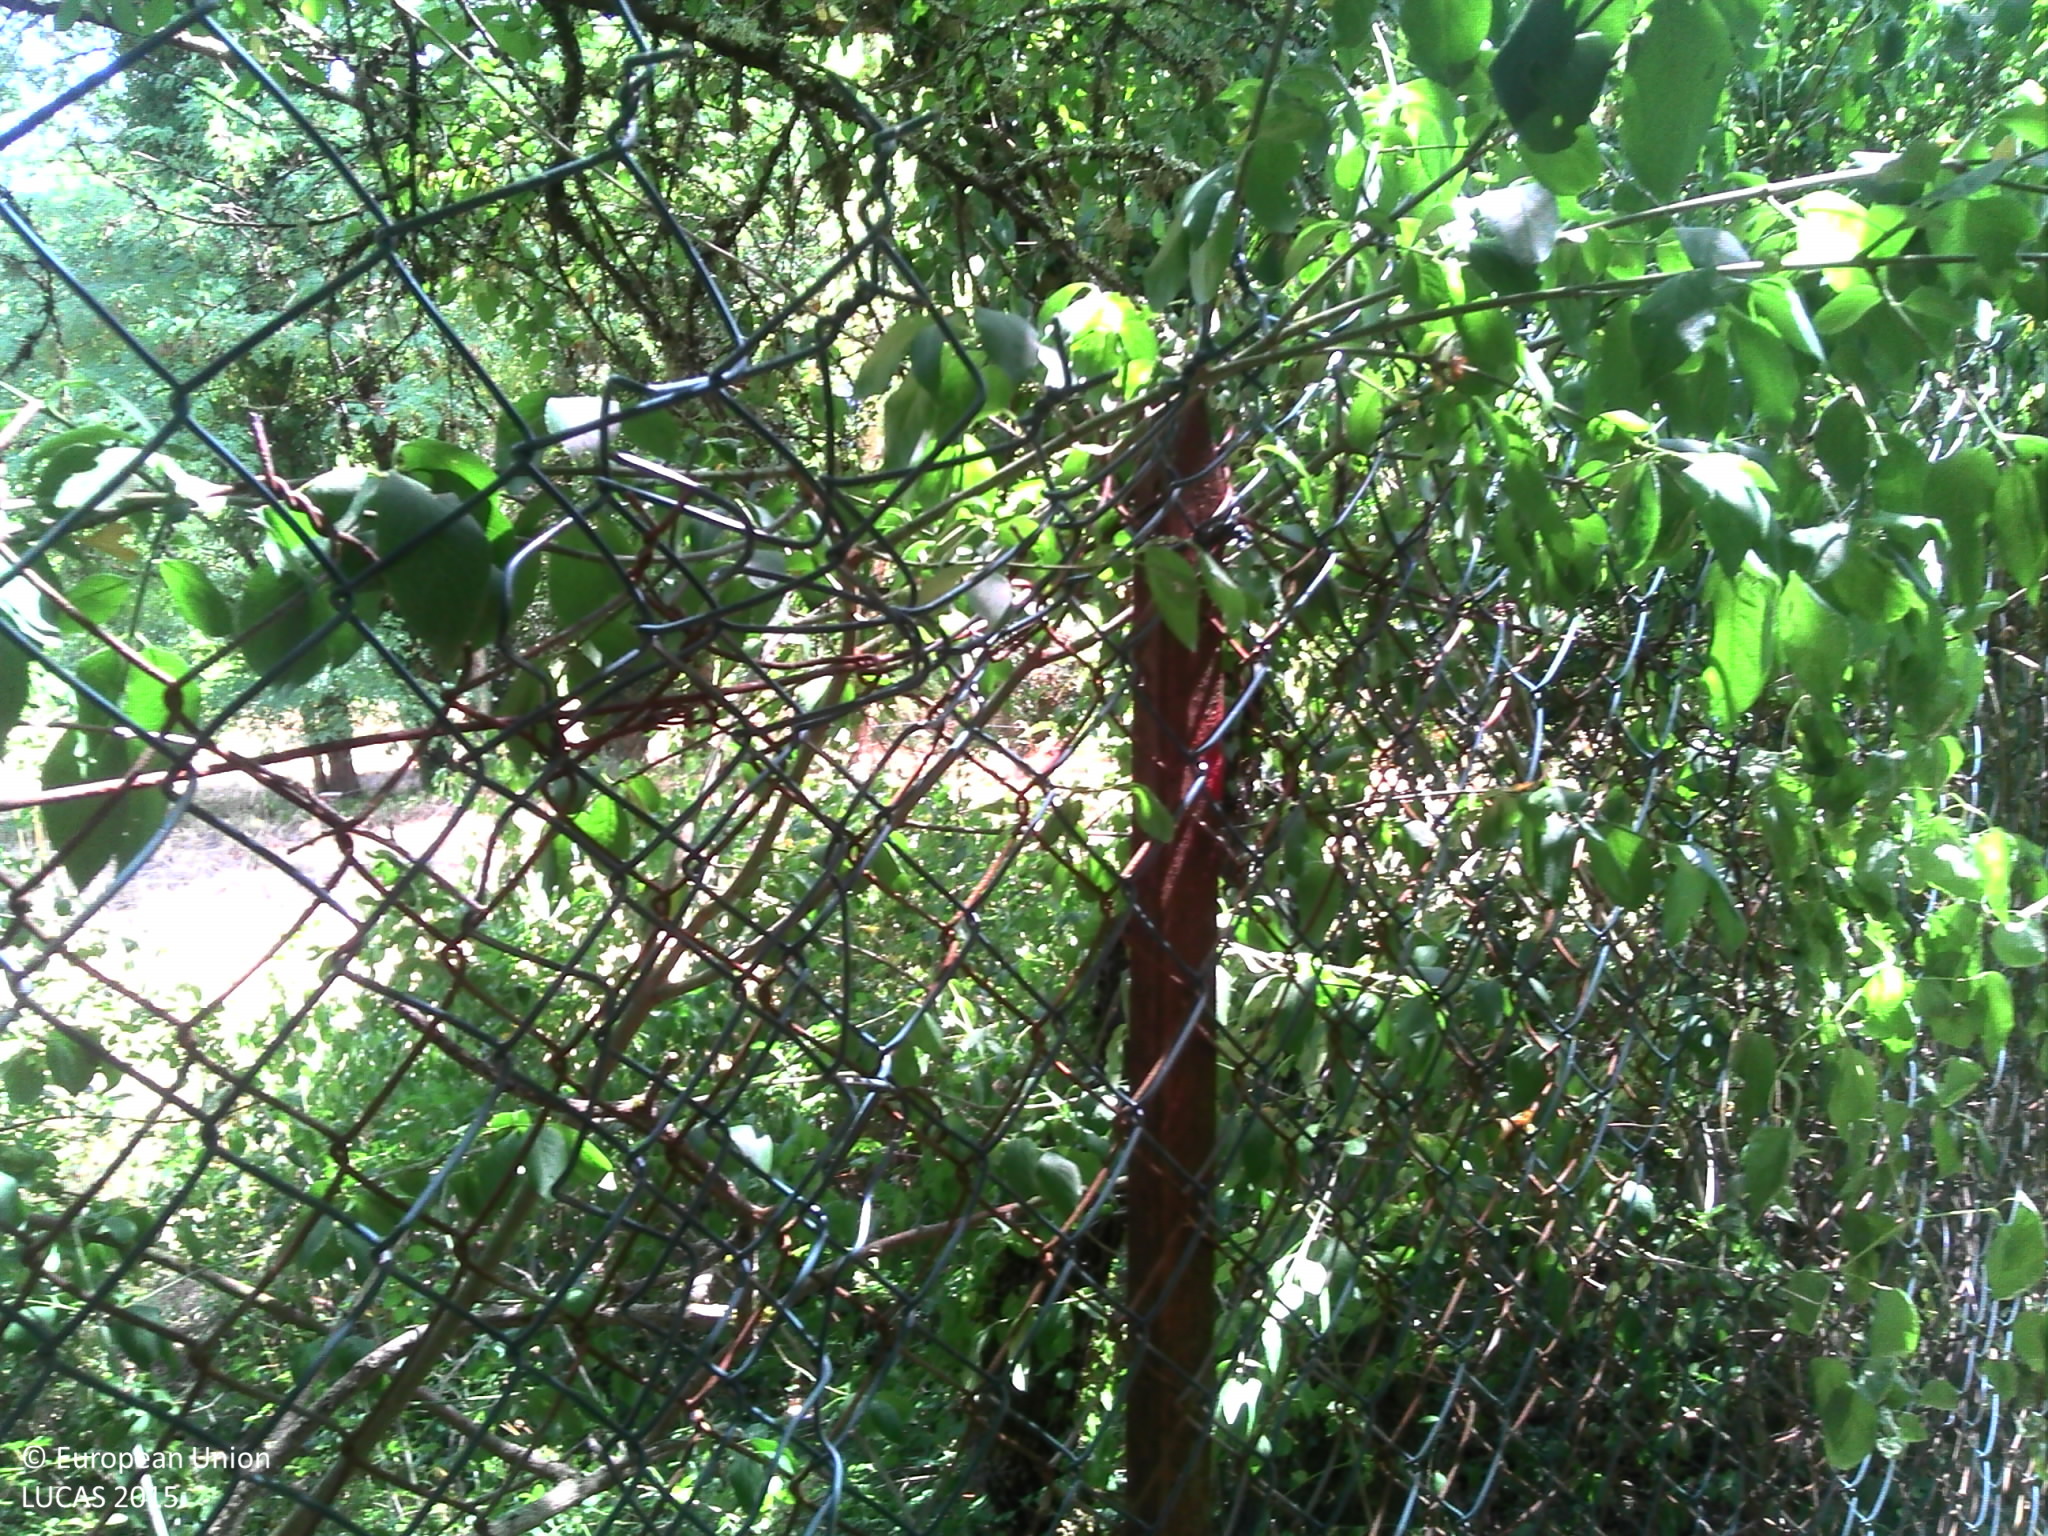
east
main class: Grassland
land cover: Grassland with sparse tree/shrub cover
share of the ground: > 75 %
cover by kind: herbaceous plants 95 %, broadleaved forest trees 5 %
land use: Agriculture (excluding fallow land and kitchen gardens)
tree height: > 5 m
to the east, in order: Grassland with sparse tree/shrub cover; Broadleaved woodland; Inland fresh running water; Rocks and stones; Inland fresh running water; Rocks and stones; Broadleaved woodland
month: July
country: FR
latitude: 44.4477
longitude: 4.3144
